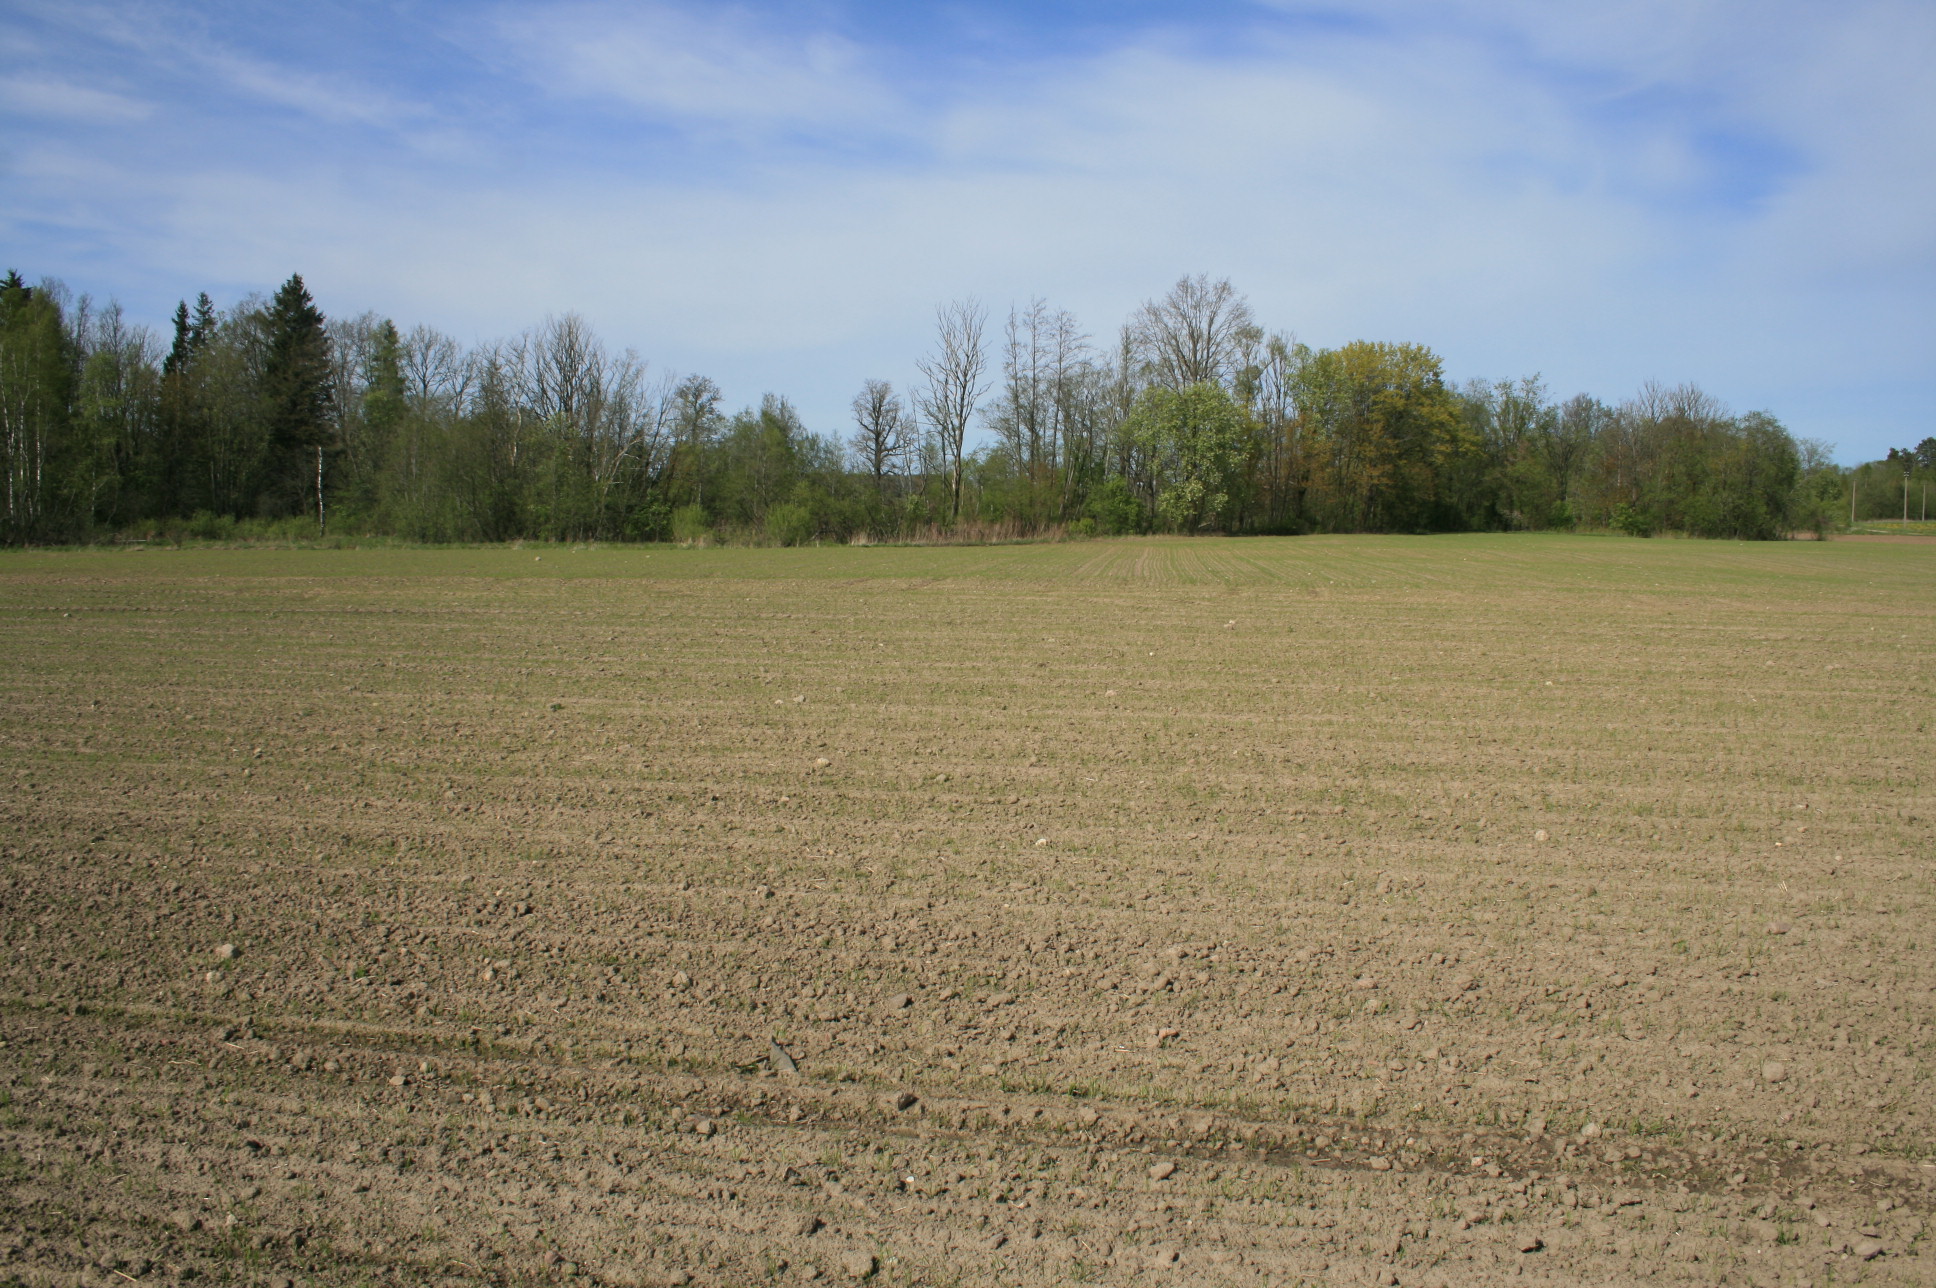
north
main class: Cropland
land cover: Barley
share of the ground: 10 - 25 %
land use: Agriculture (excluding fallow land and kitchen gardens)
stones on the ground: < 10 %
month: May
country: LT
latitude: 55.9742
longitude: 21.3390
